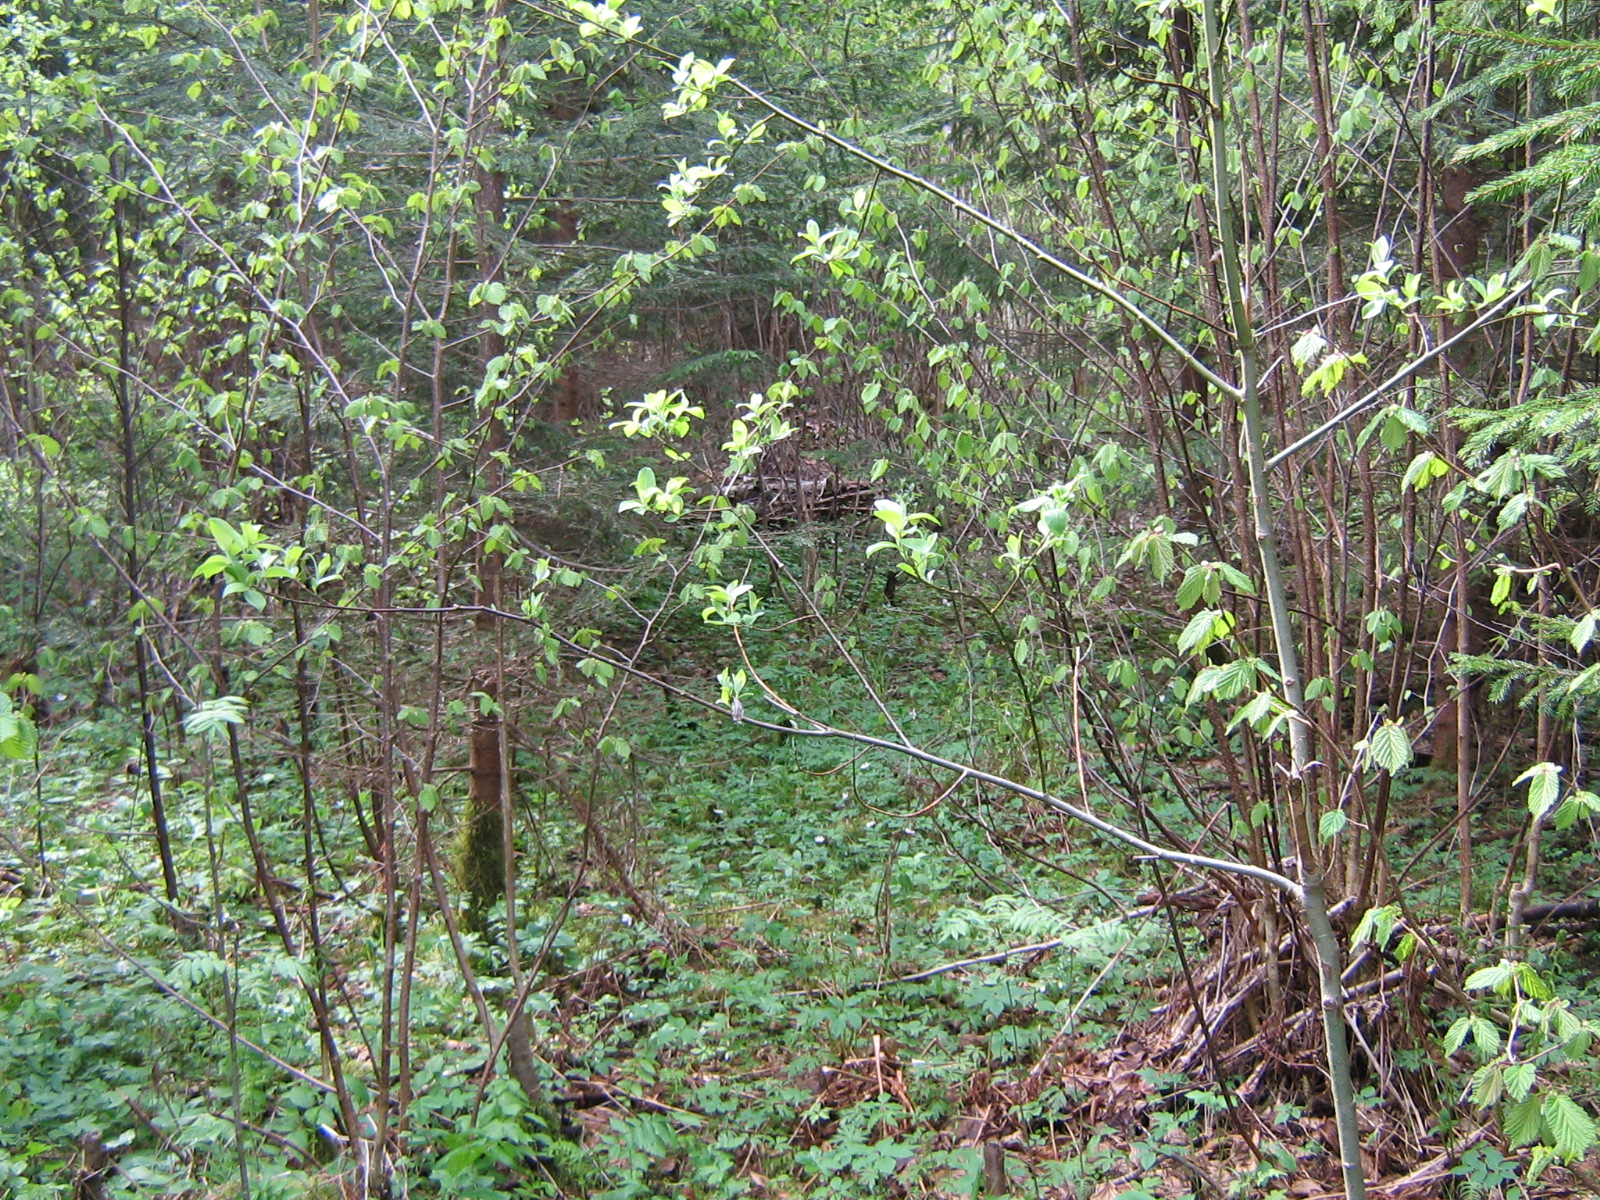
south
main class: Woodland
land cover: Spruce dominated mixed woodland
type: hemiboreal forest and nemoral coniferous forest and mixed broadleaved-coniferous forest
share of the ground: > 75 %
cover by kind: coniferous forest trees 75 %, broadleaved forest trees 25 %
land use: Forestry
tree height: > 5 m
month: May
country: LV
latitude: 57.2161
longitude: 25.5337
